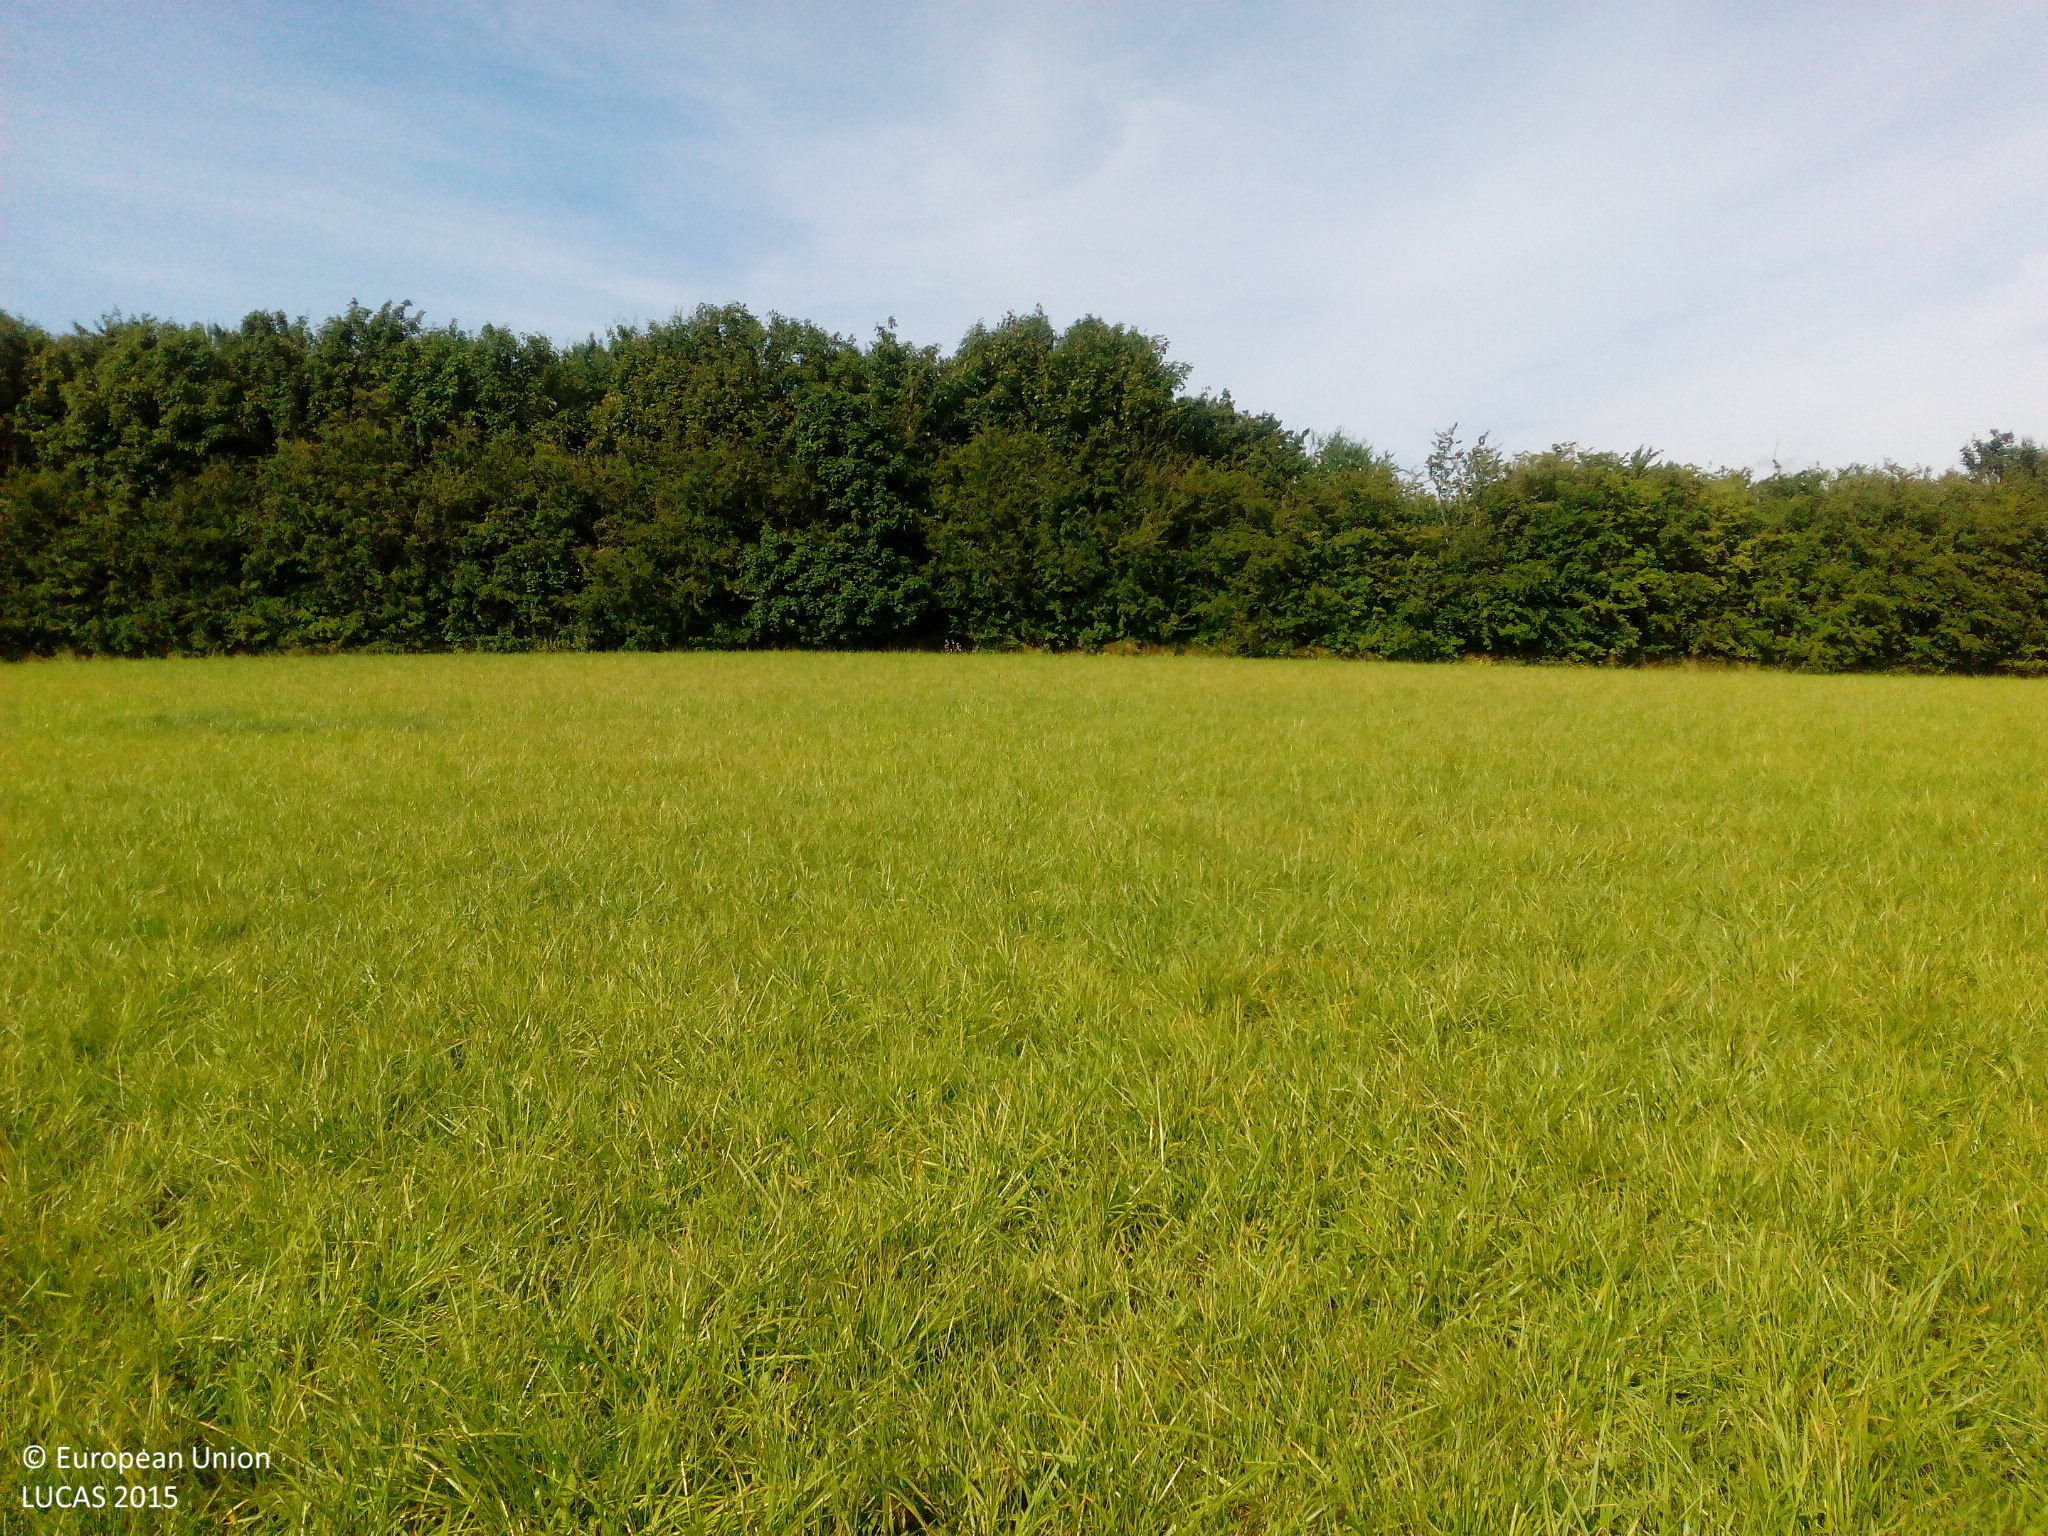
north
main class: Grassland
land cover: Grassland without tree/shrub cover
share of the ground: > 75 %
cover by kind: herbaceous plants 100 %
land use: Agriculture (excluding fallow land and kitchen gardens)
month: August
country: DK
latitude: 55.6140
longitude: 12.0464
